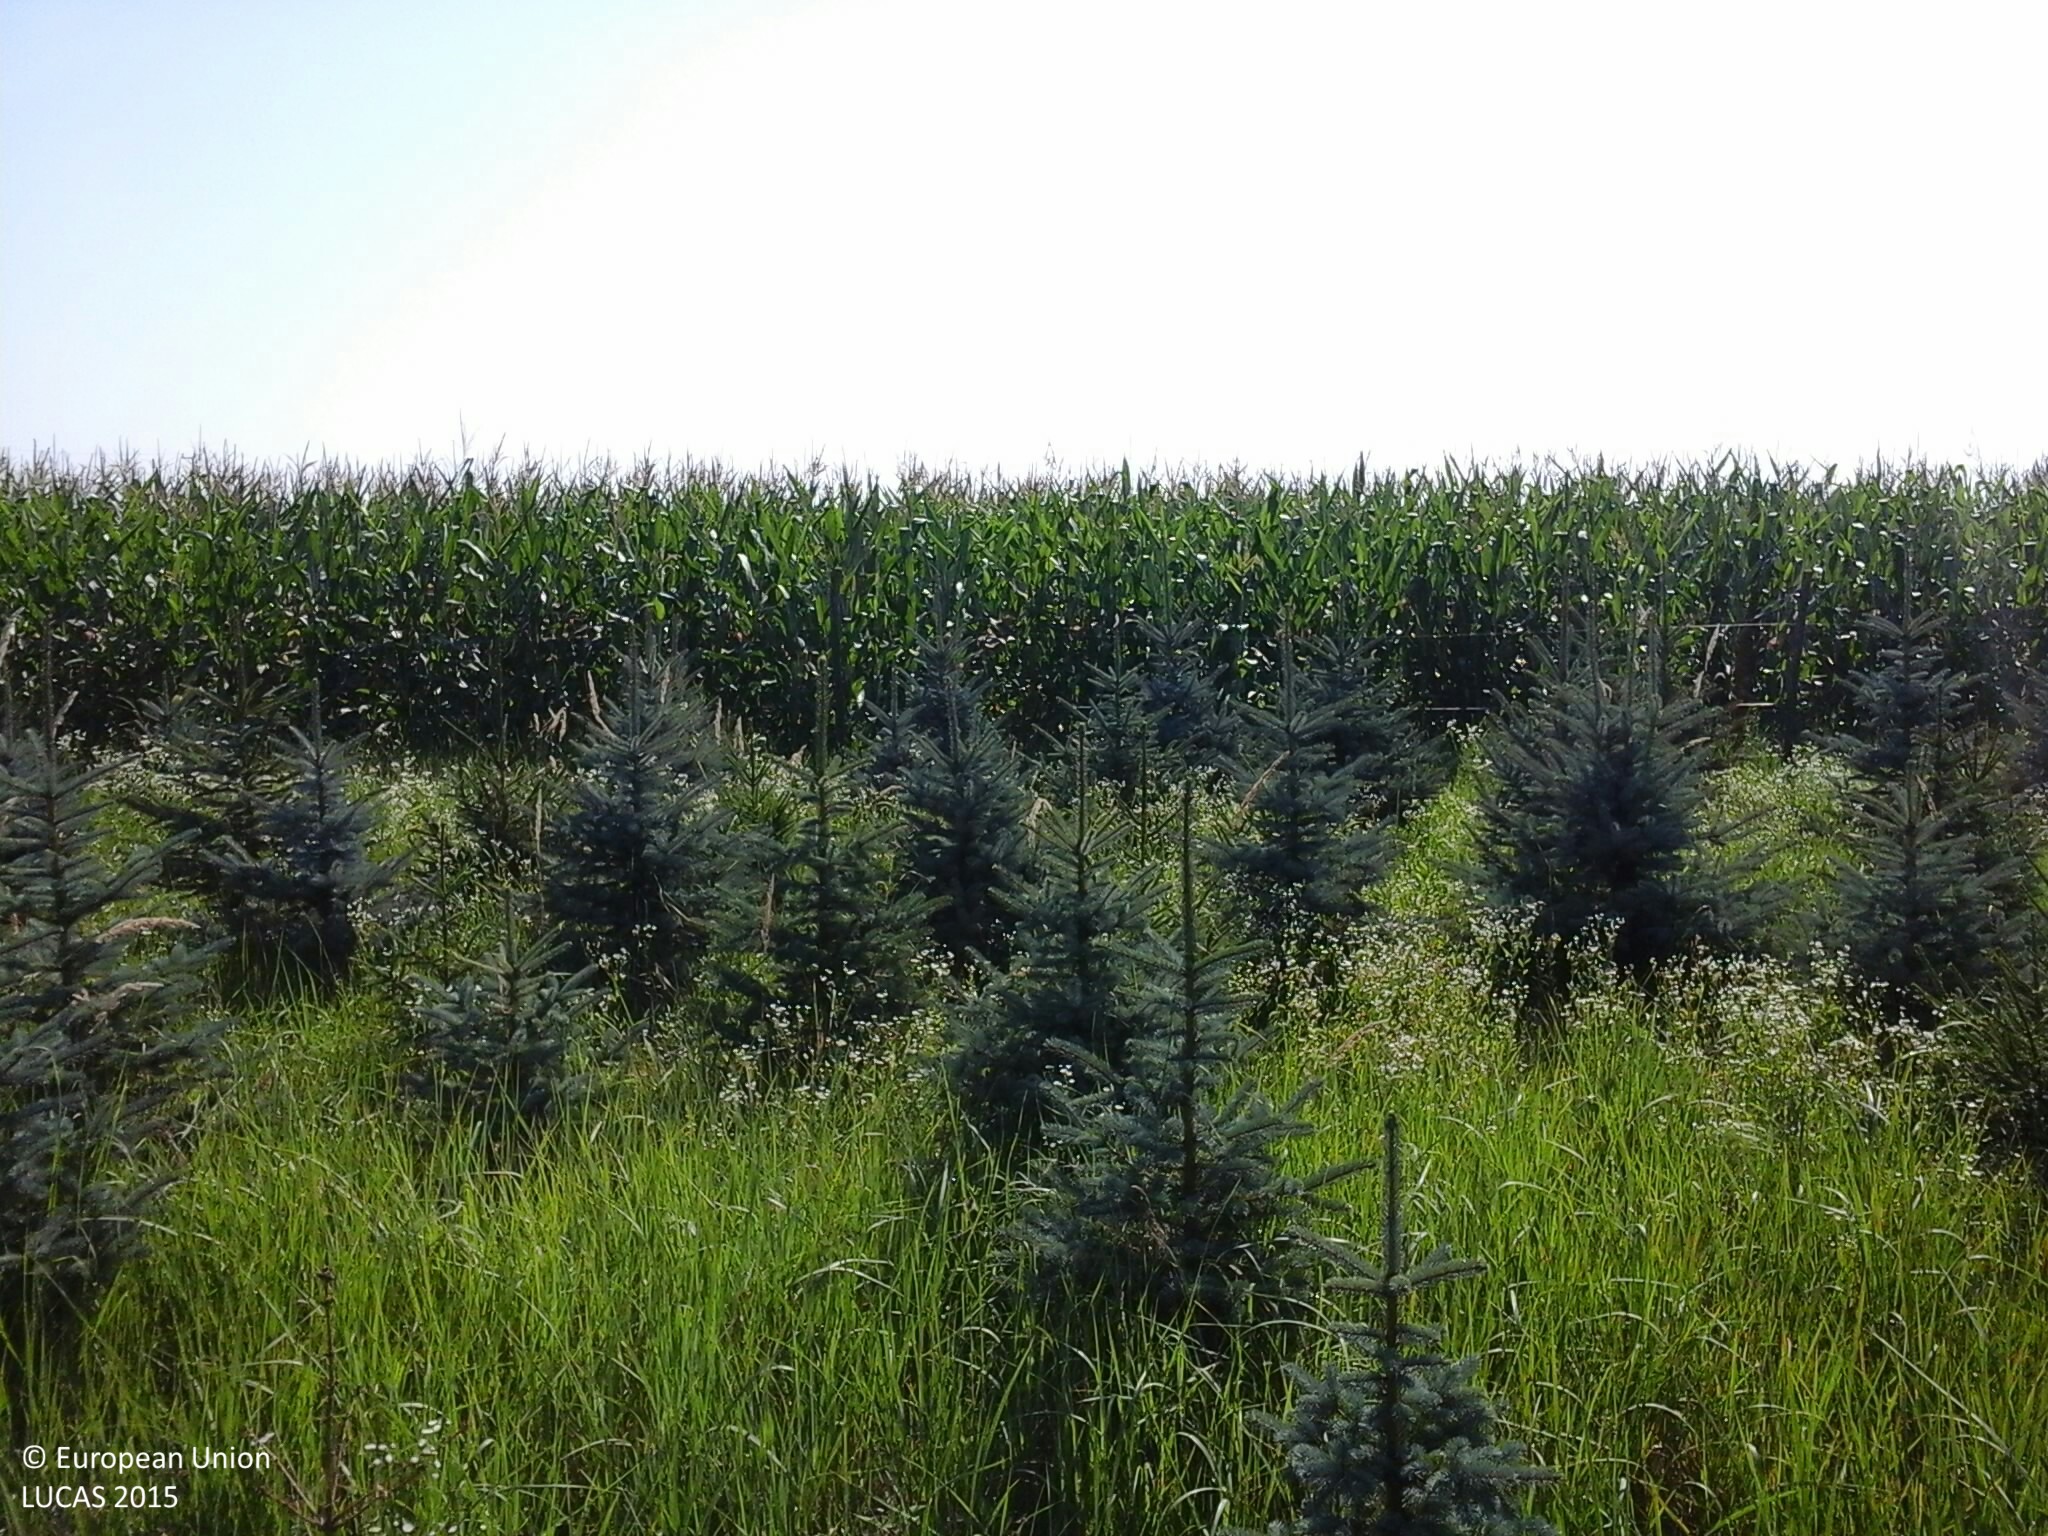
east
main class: Cropland
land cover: Maize
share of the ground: > 75 %
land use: Agriculture (excluding fallow land and kitchen gardens)
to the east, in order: Maize; Shrubland without tree cover; Ditches and canals; Shrubland without tree cover; Maize; Grass margins; Fences; Spruce dominated coniferous woodland; Grass margins; Fences; Grass margins; Maize
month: July
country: HU
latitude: 46.9690
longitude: 16.4558
